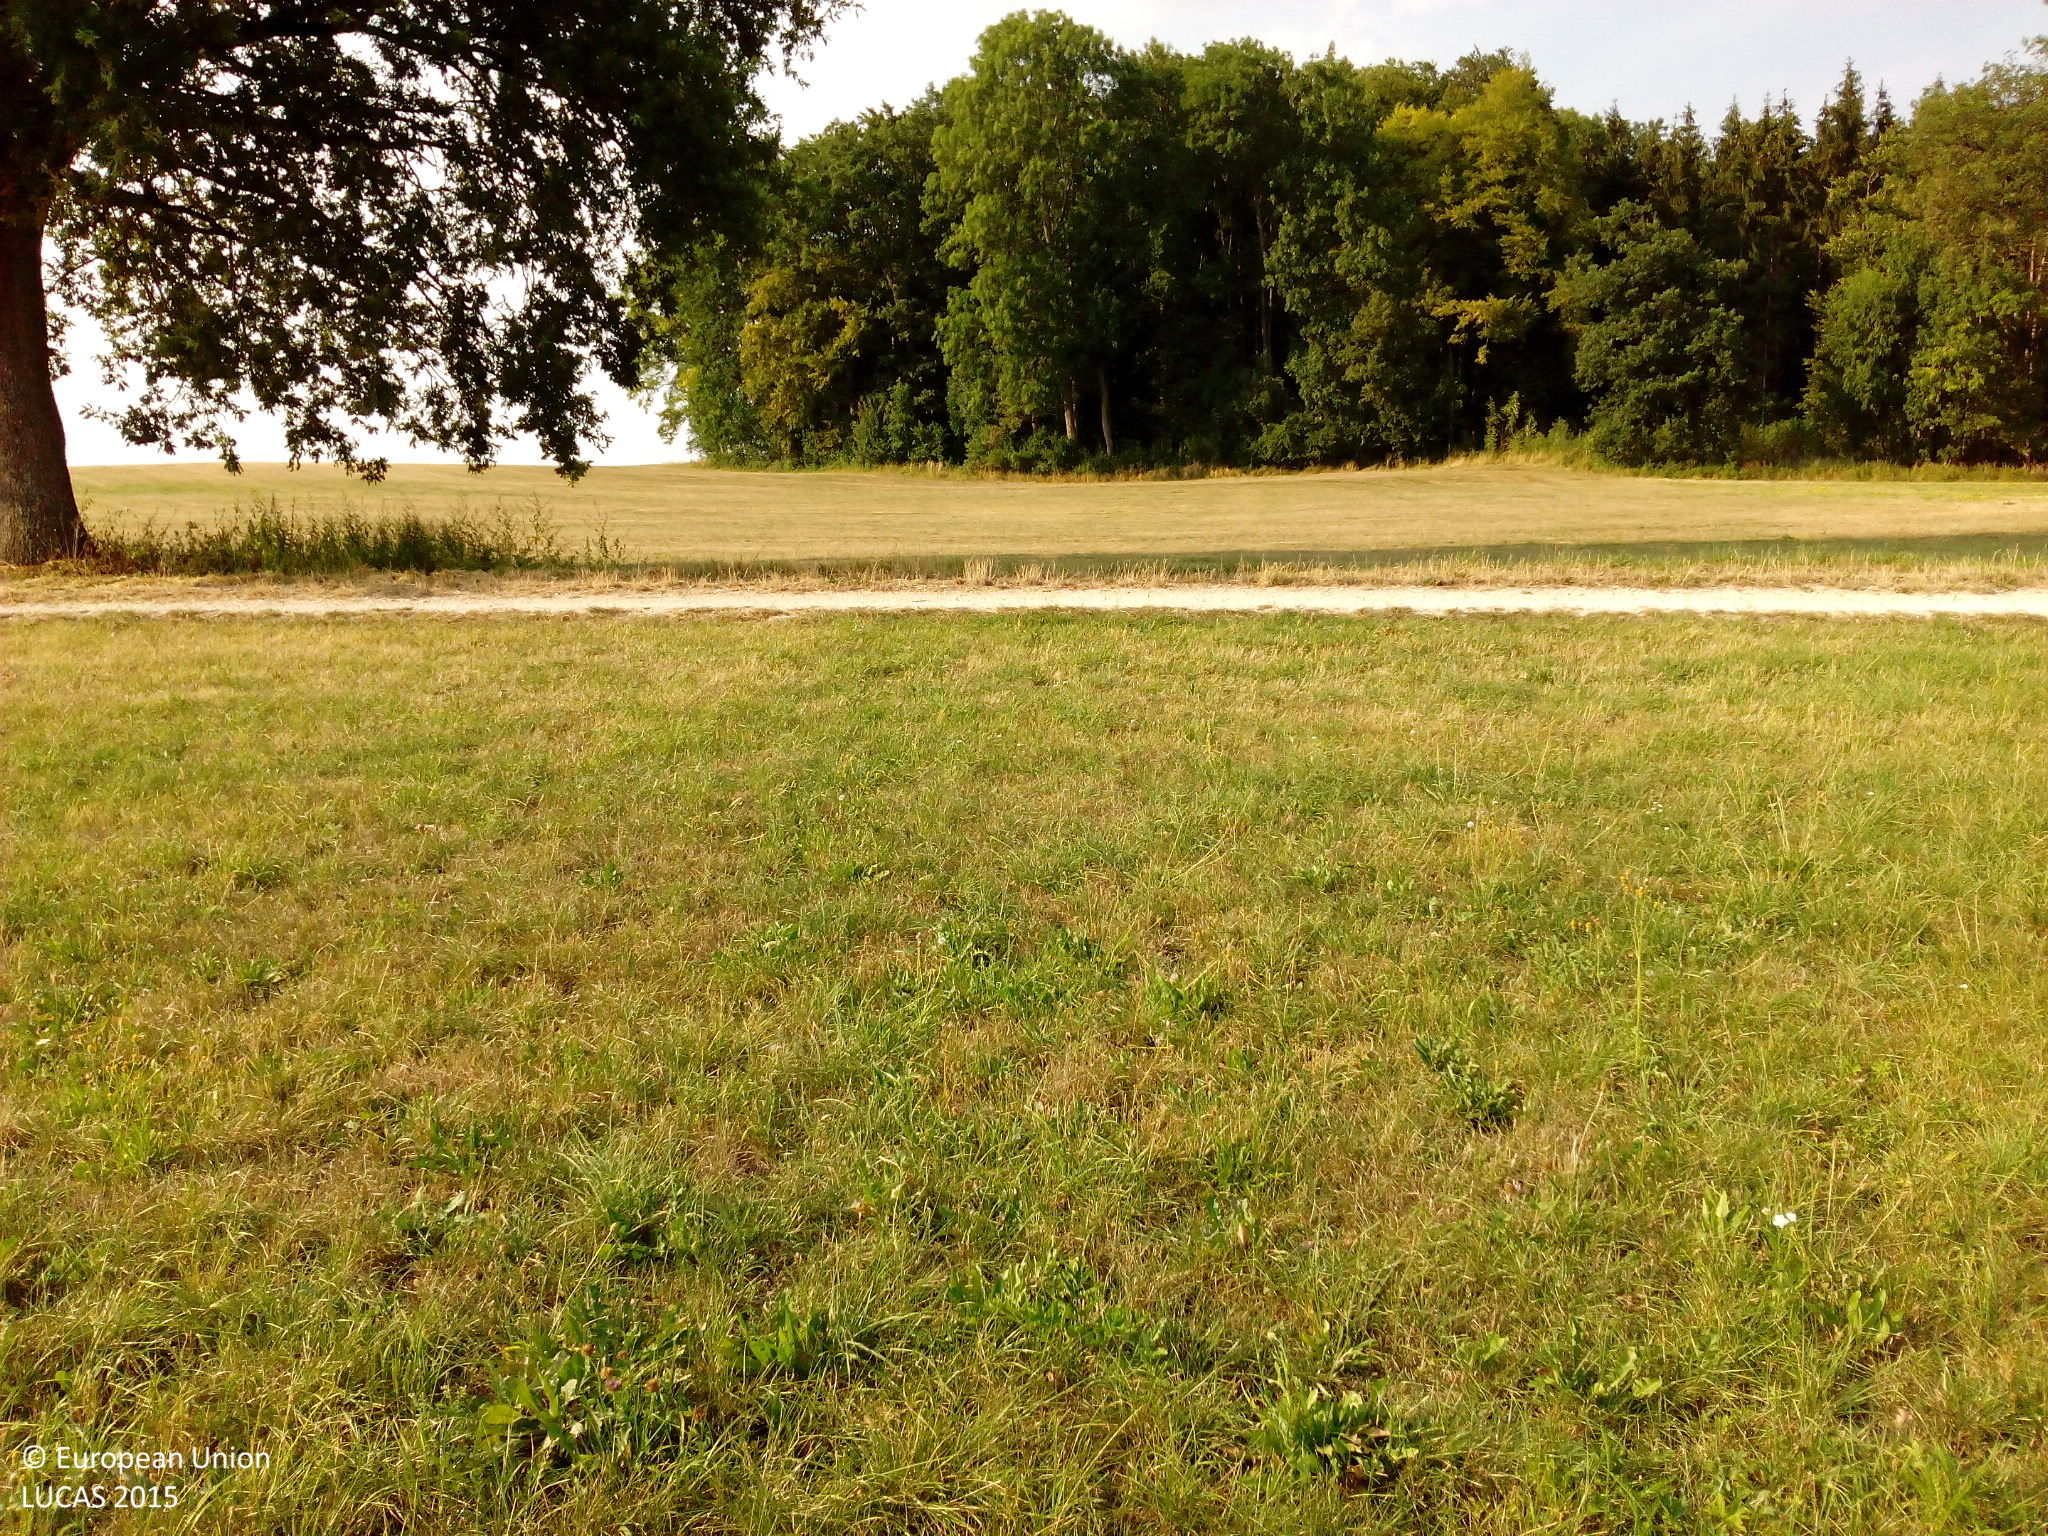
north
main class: Grassland
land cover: Grassland without tree/shrub cover
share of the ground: > 75 %
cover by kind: herbaceous plants 95 %, unconsolidated bare surface 5 %
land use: Agriculture (excluding fallow land and kitchen gardens)
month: August
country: DE
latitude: 48.6909
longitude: 10.3123
